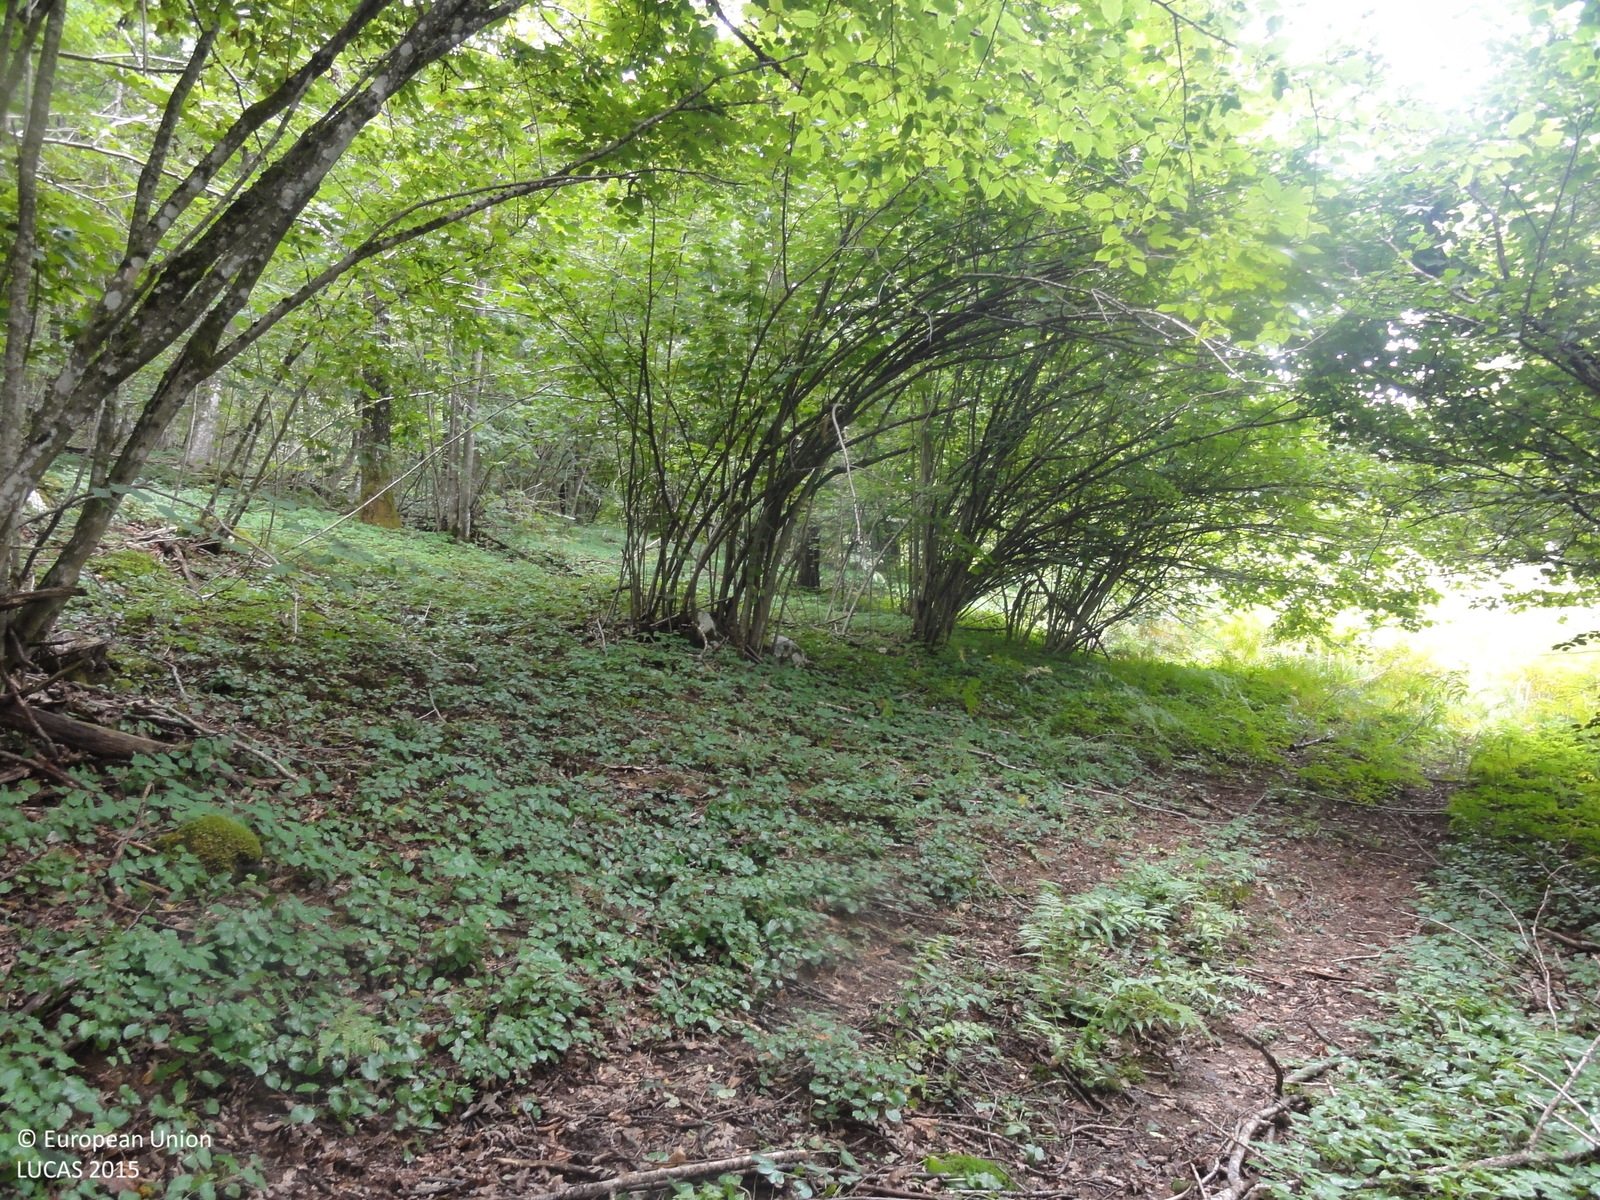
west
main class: Woodland
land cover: Broadleaved woodland
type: mesophytic deciduous forest
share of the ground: > 75 %
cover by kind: broadleaved forest trees 90 %, shrubs 5 %, herbaceous plants 5 %
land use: Forestry
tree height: > 5 m
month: August
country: SI
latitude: 45.7914
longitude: 14.8202
